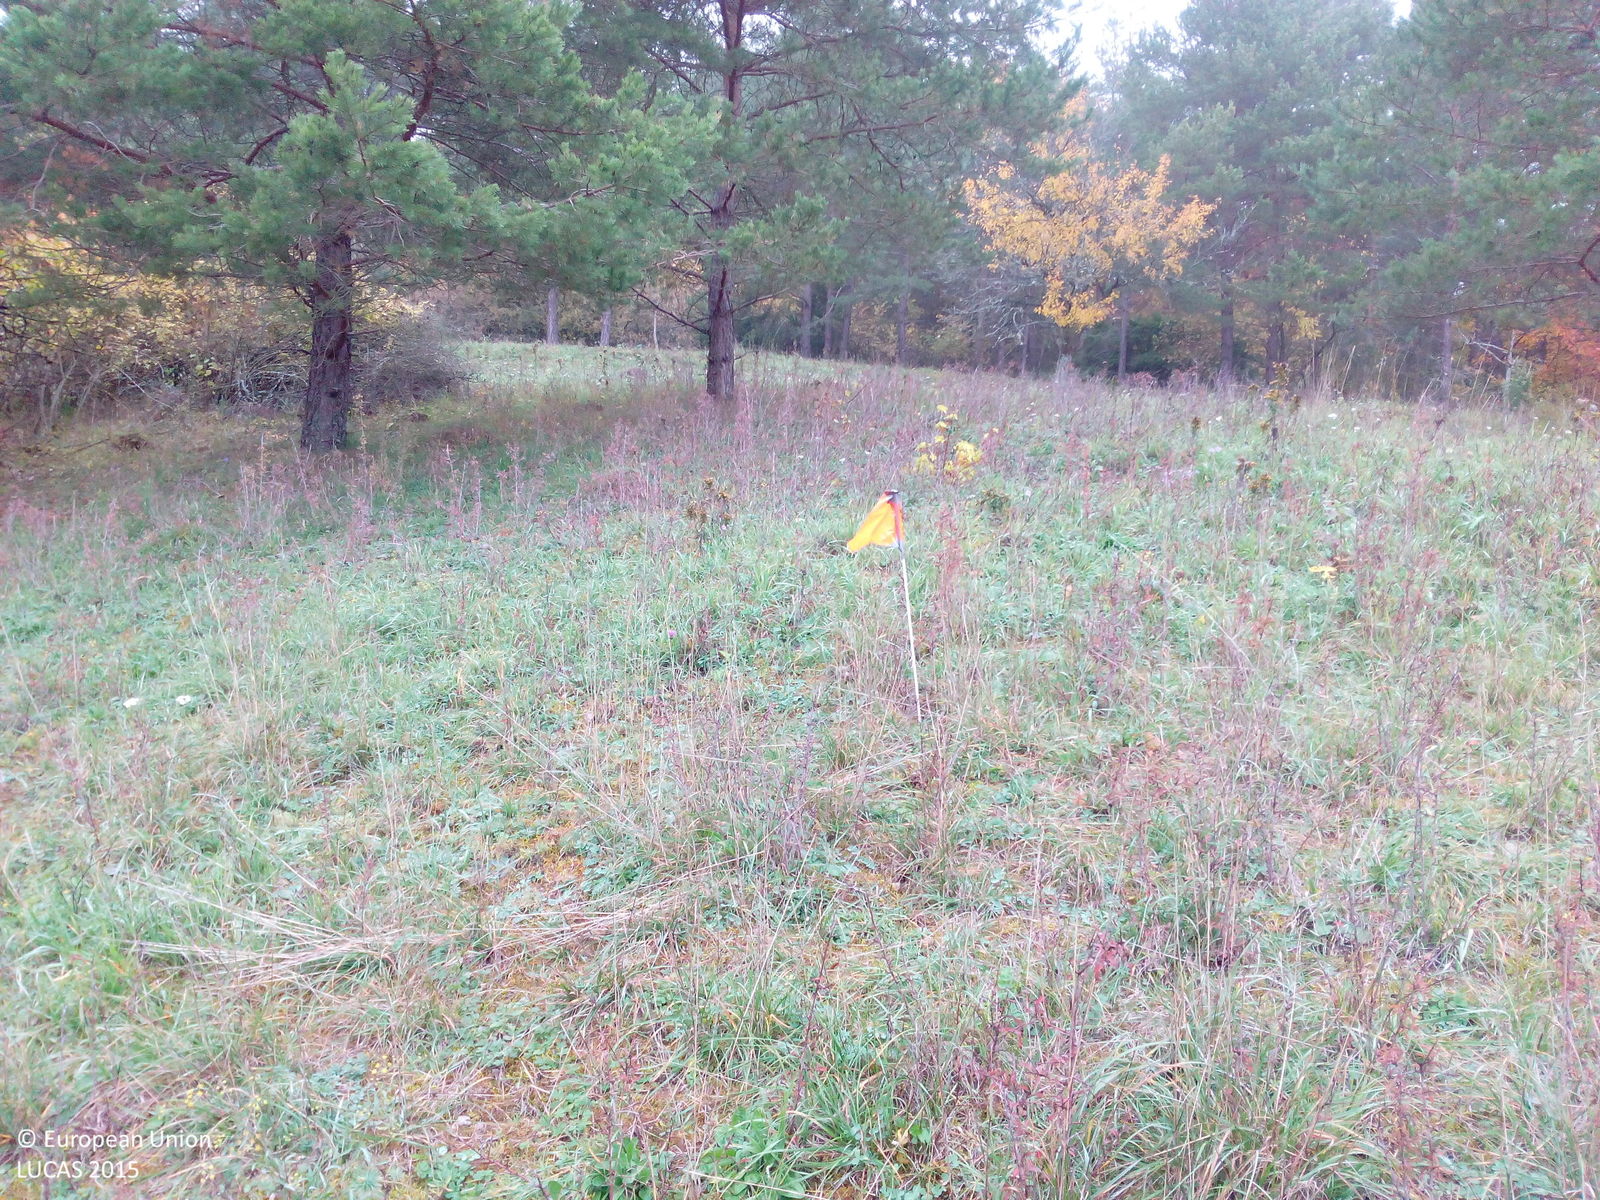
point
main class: Grassland
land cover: Grassland with sparse tree/shrub cover
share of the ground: > 75 %
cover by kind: herbaceous plants 90 %, coniferous forest trees 5 %, lichens and mosses 5 %
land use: Semi-natural and natural areas not in use
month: October
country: DE
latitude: 50.1482
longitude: 9.9301
